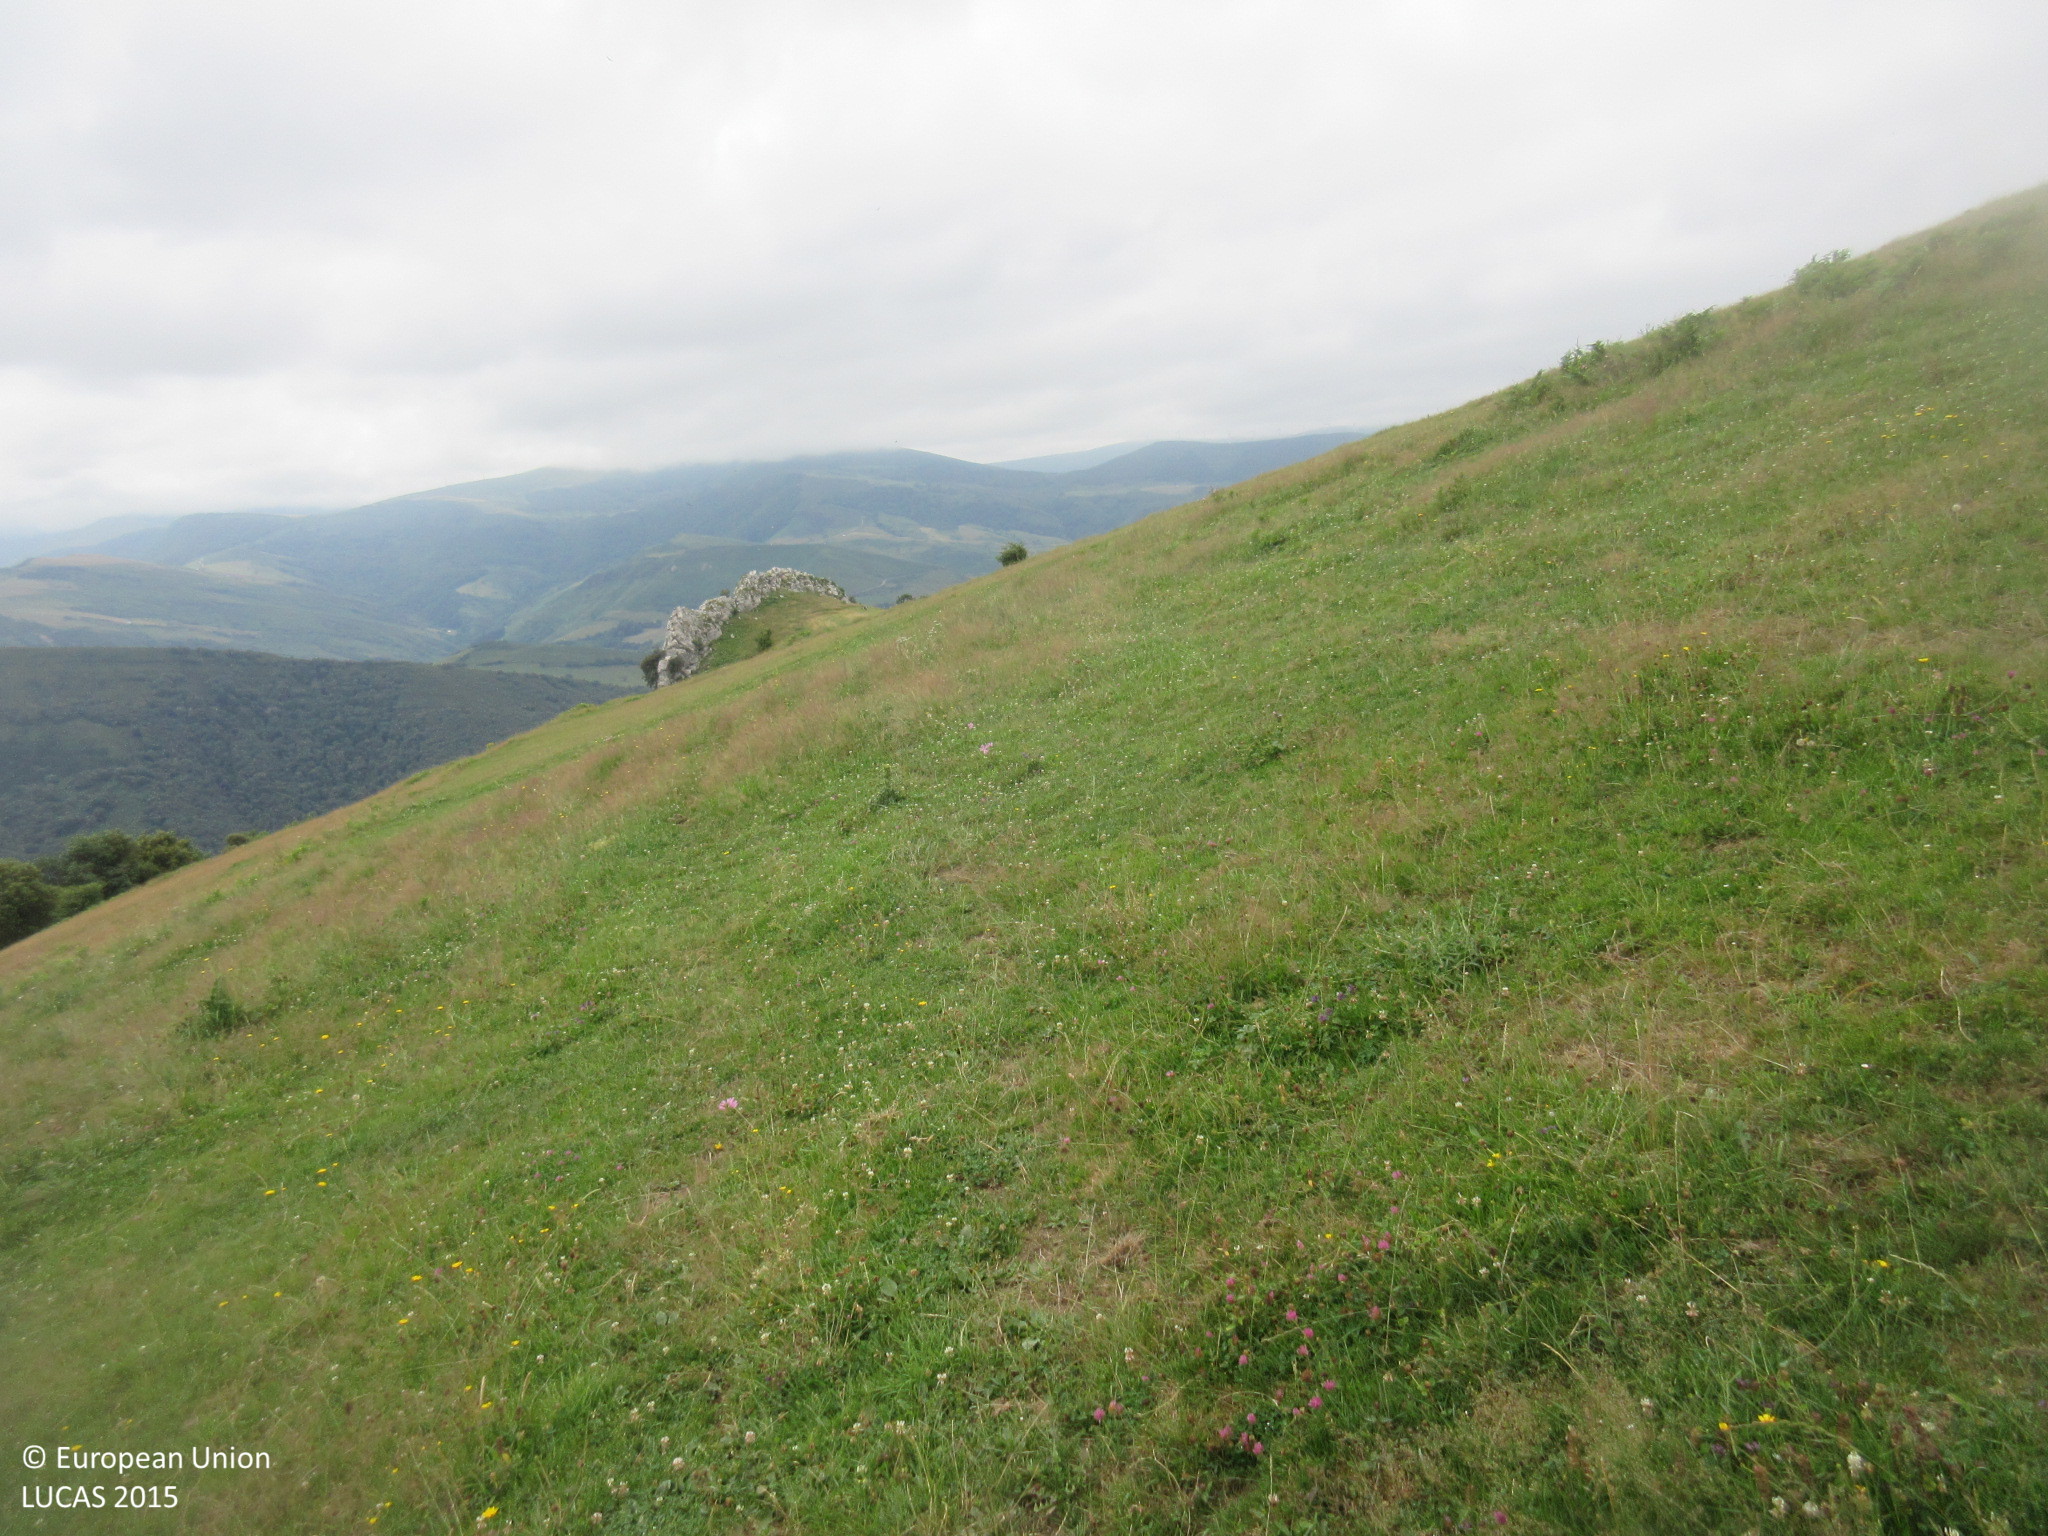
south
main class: Grassland
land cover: Grassland without tree/shrub cover
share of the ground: > 75 %
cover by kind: herbaceous plants 100 %
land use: Agriculture (excluding fallow land and kitchen gardens)
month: July
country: ES
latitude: 43.2054
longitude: -3.5192
